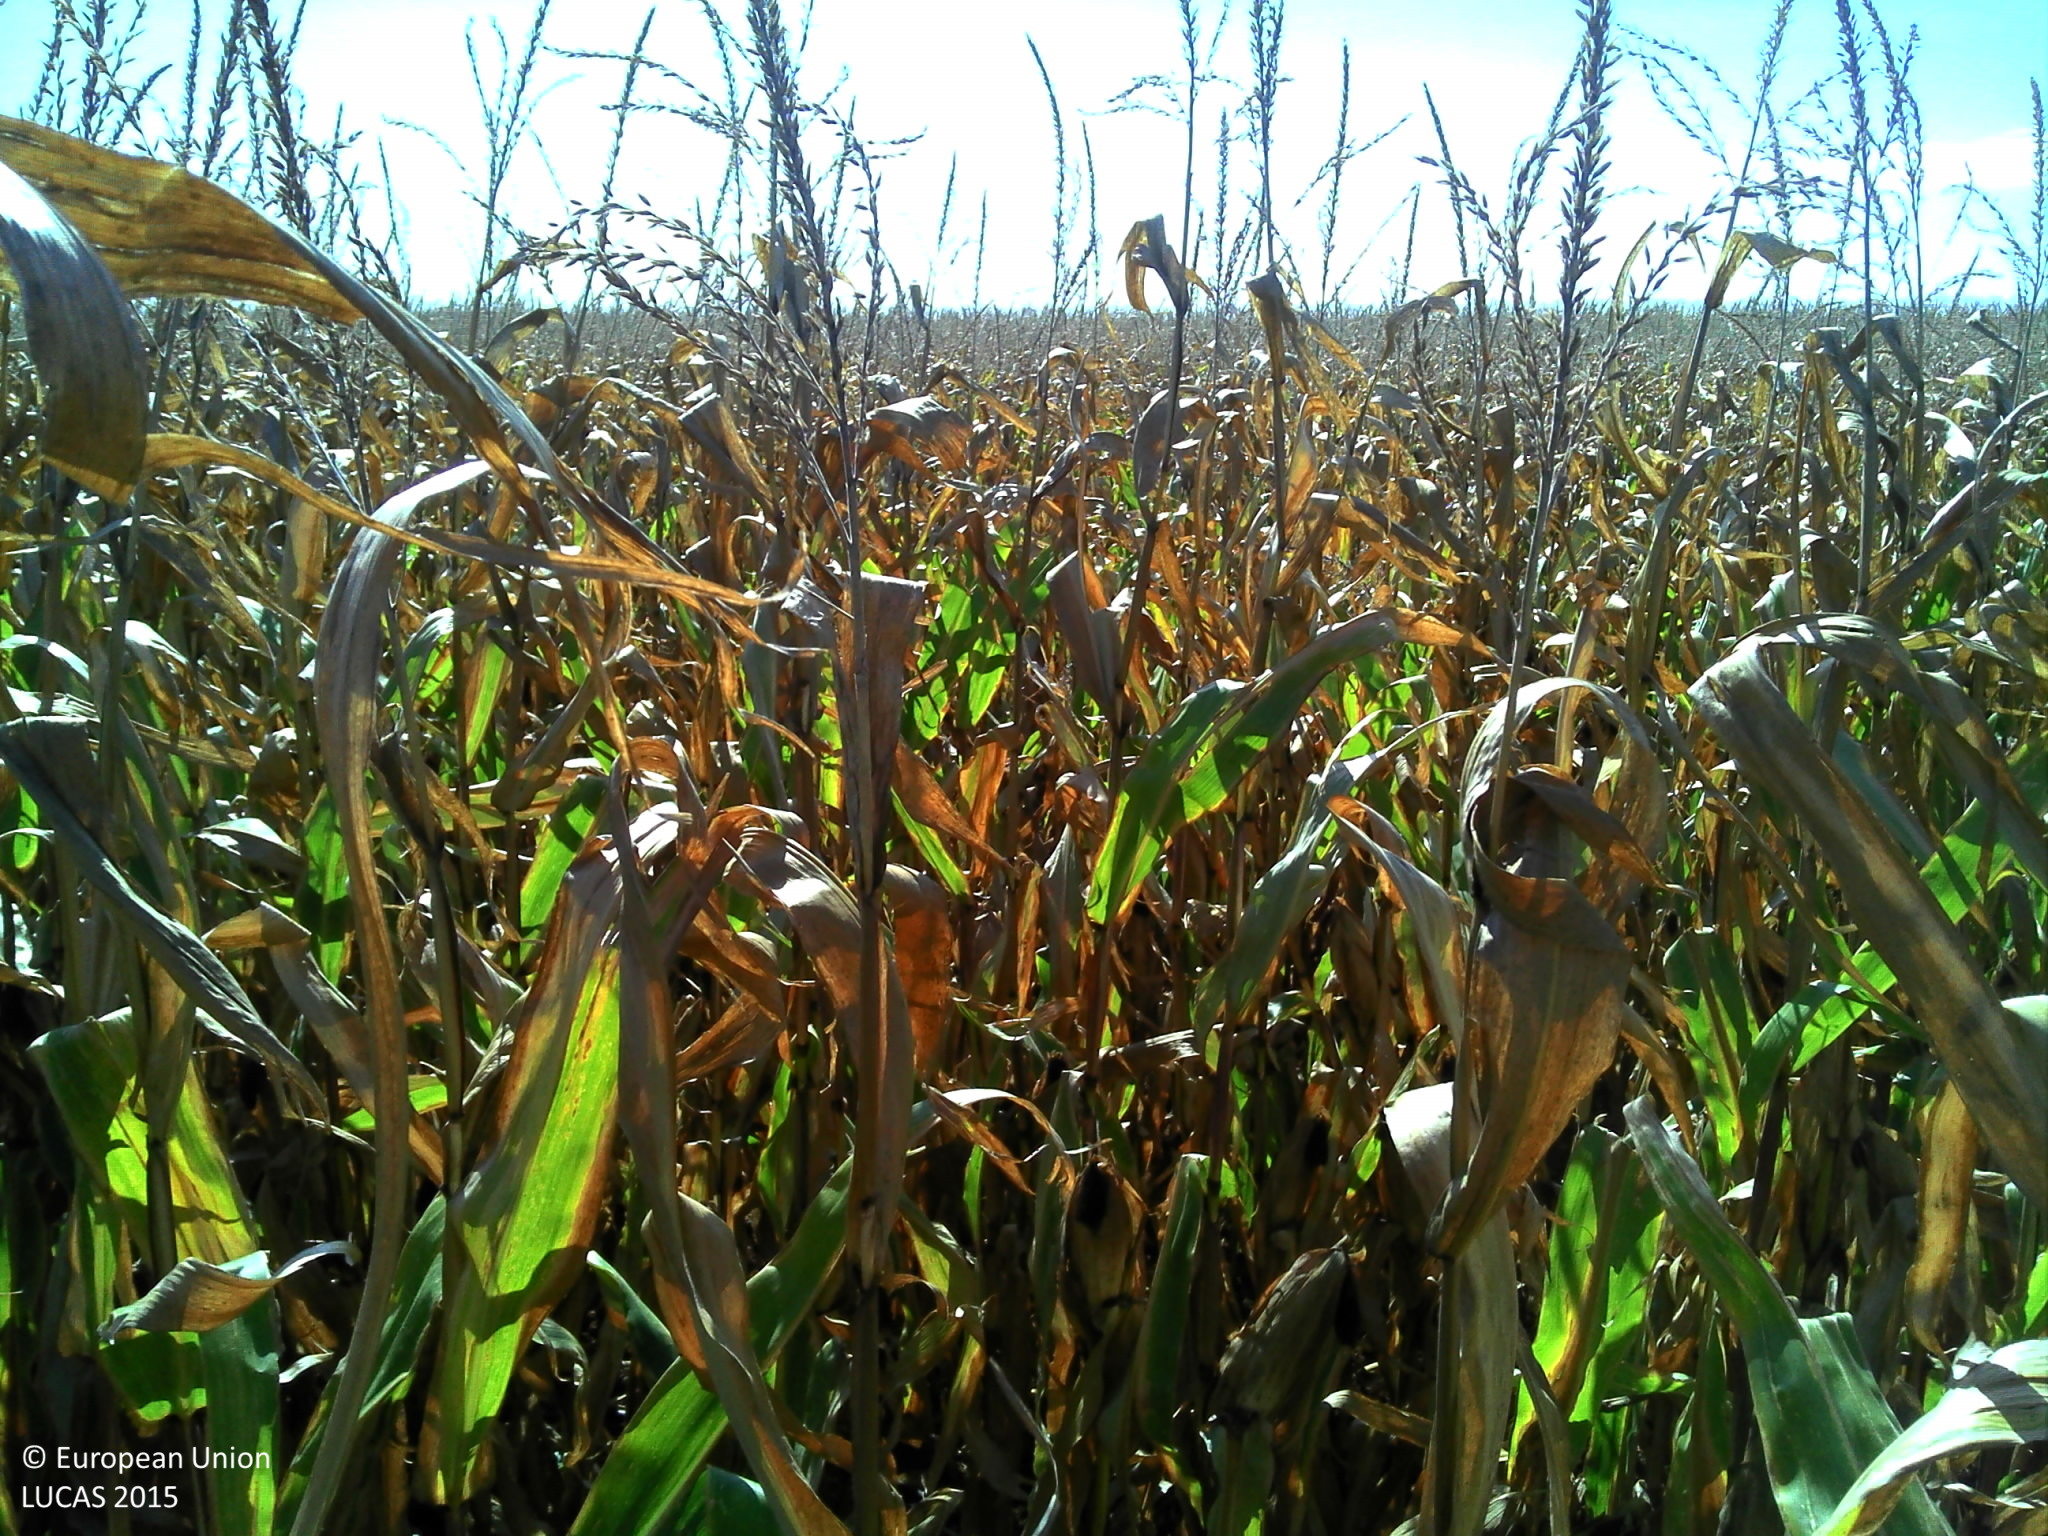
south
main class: Cropland
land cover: Maize
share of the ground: > 75 %
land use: Agriculture (excluding fallow land and kitchen gardens)
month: September
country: FR
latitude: 46.4963
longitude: -1.1212
